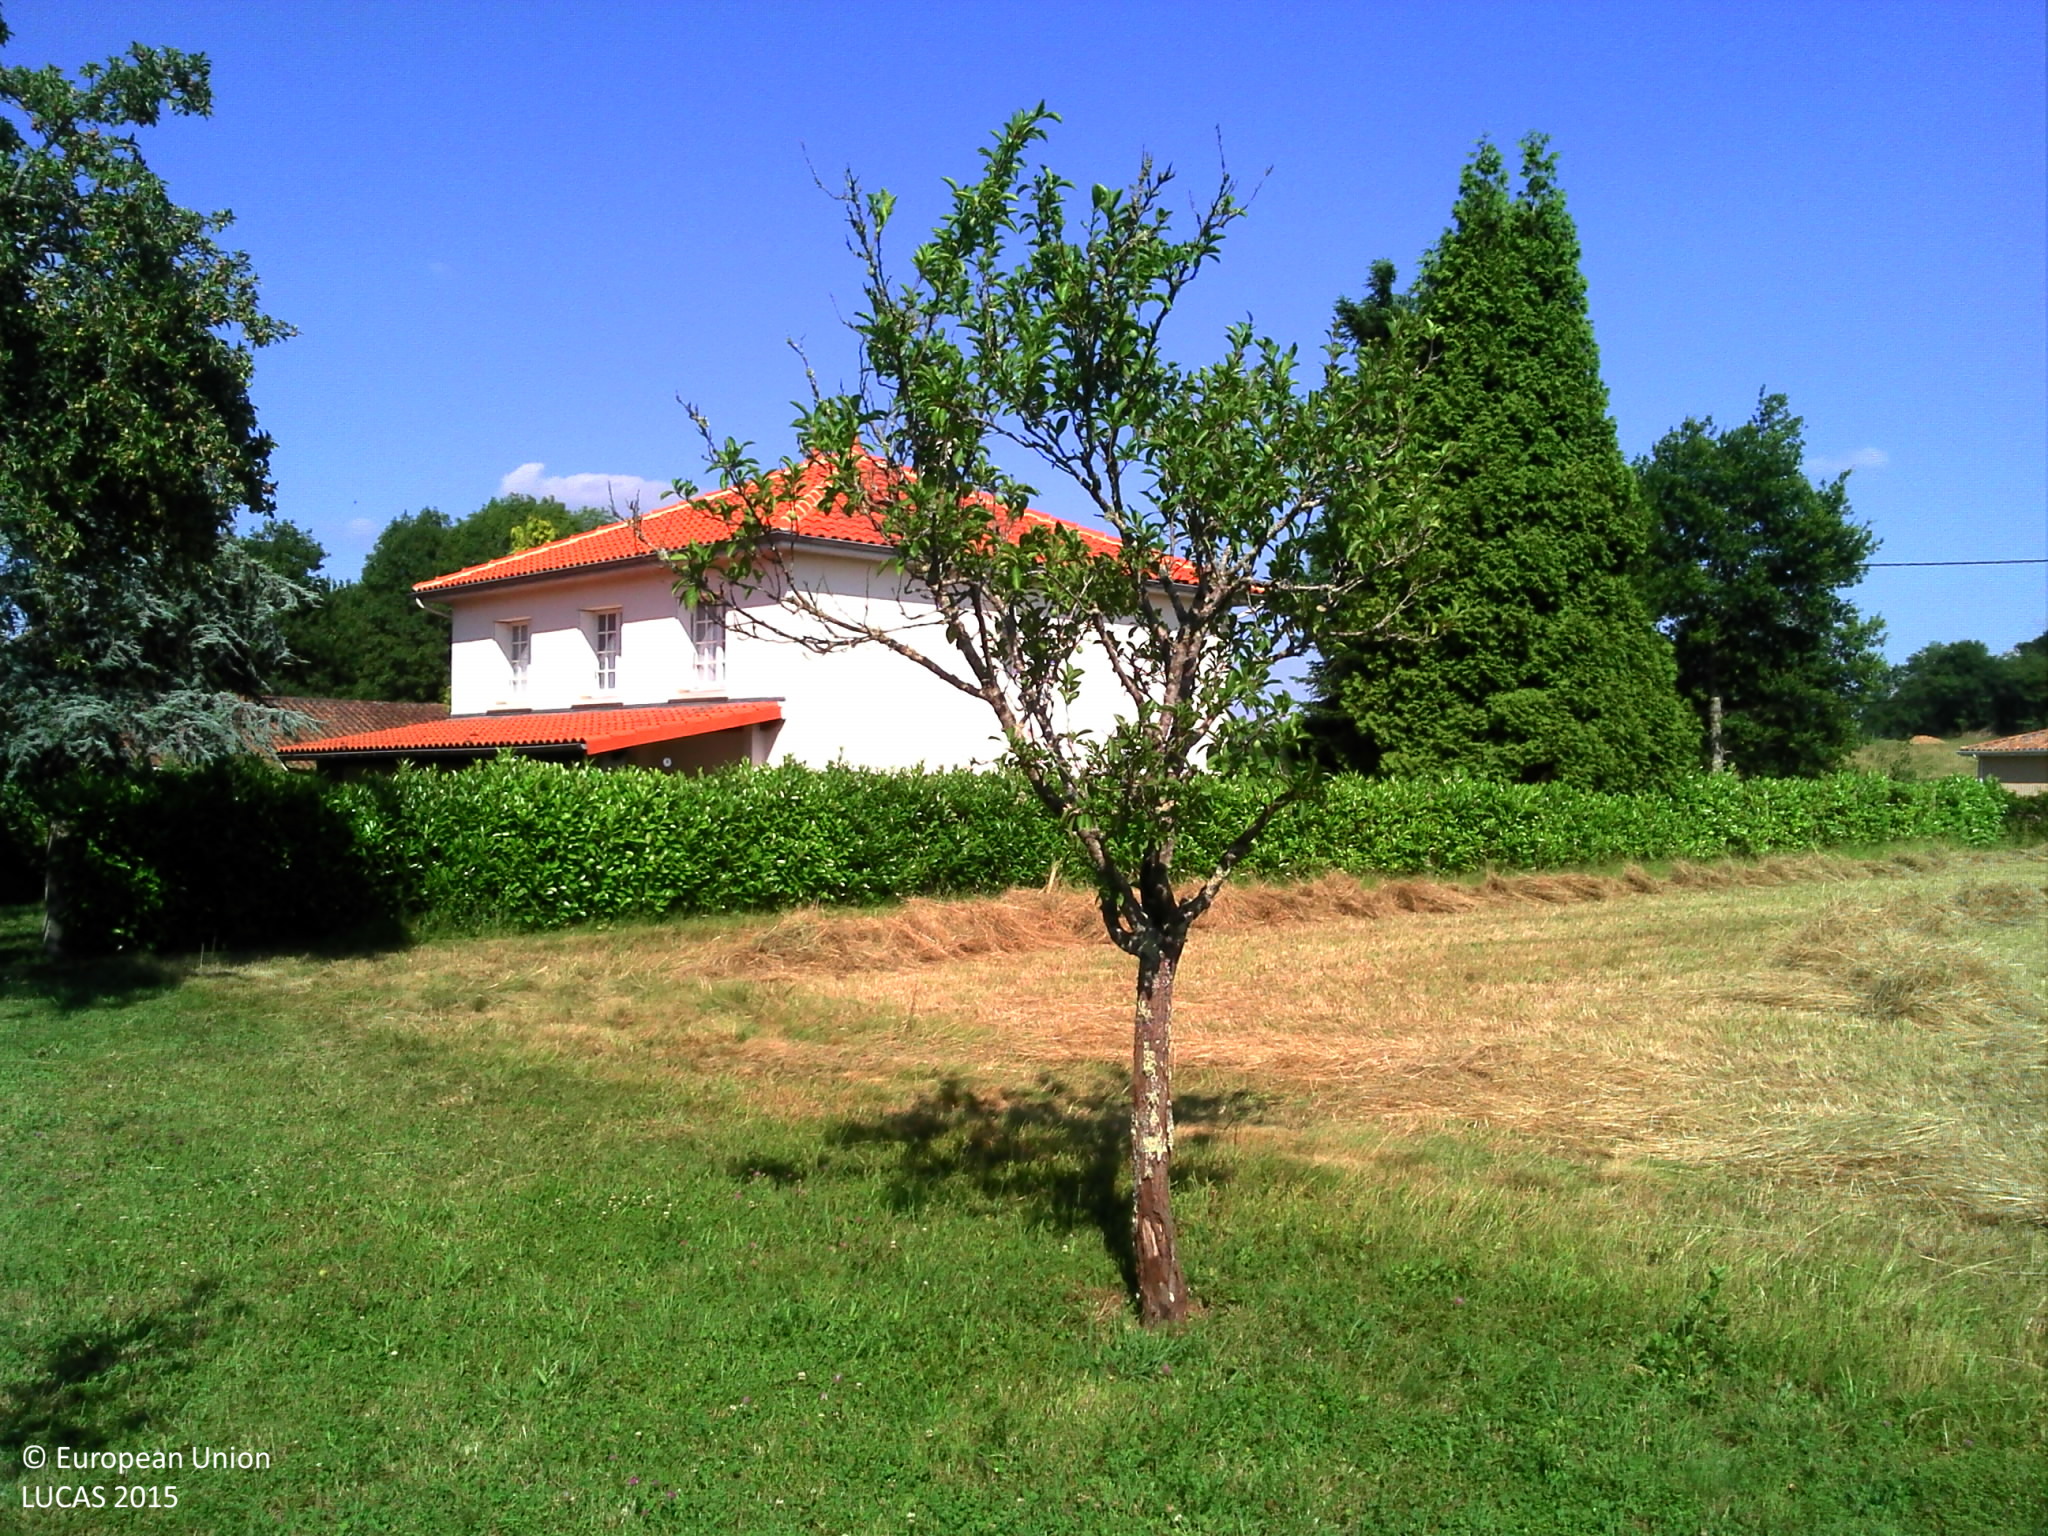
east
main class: Grassland
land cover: Grassland with sparse tree/shrub cover
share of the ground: > 75 %
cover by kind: herbaceous plants 95 %, broadleaved forest trees 5 %
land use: Agriculture (excluding fallow land and kitchen gardens)
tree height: > 5 m
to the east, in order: Grassland with sparse tree/shrub cover; Artificial constructions in urban areas; Grass margins; Paved roads, cycling and walking lanes; Grass margins; Lines of trees; Fences; Maize
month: June
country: FR
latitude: 45.8860
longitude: 0.6440
